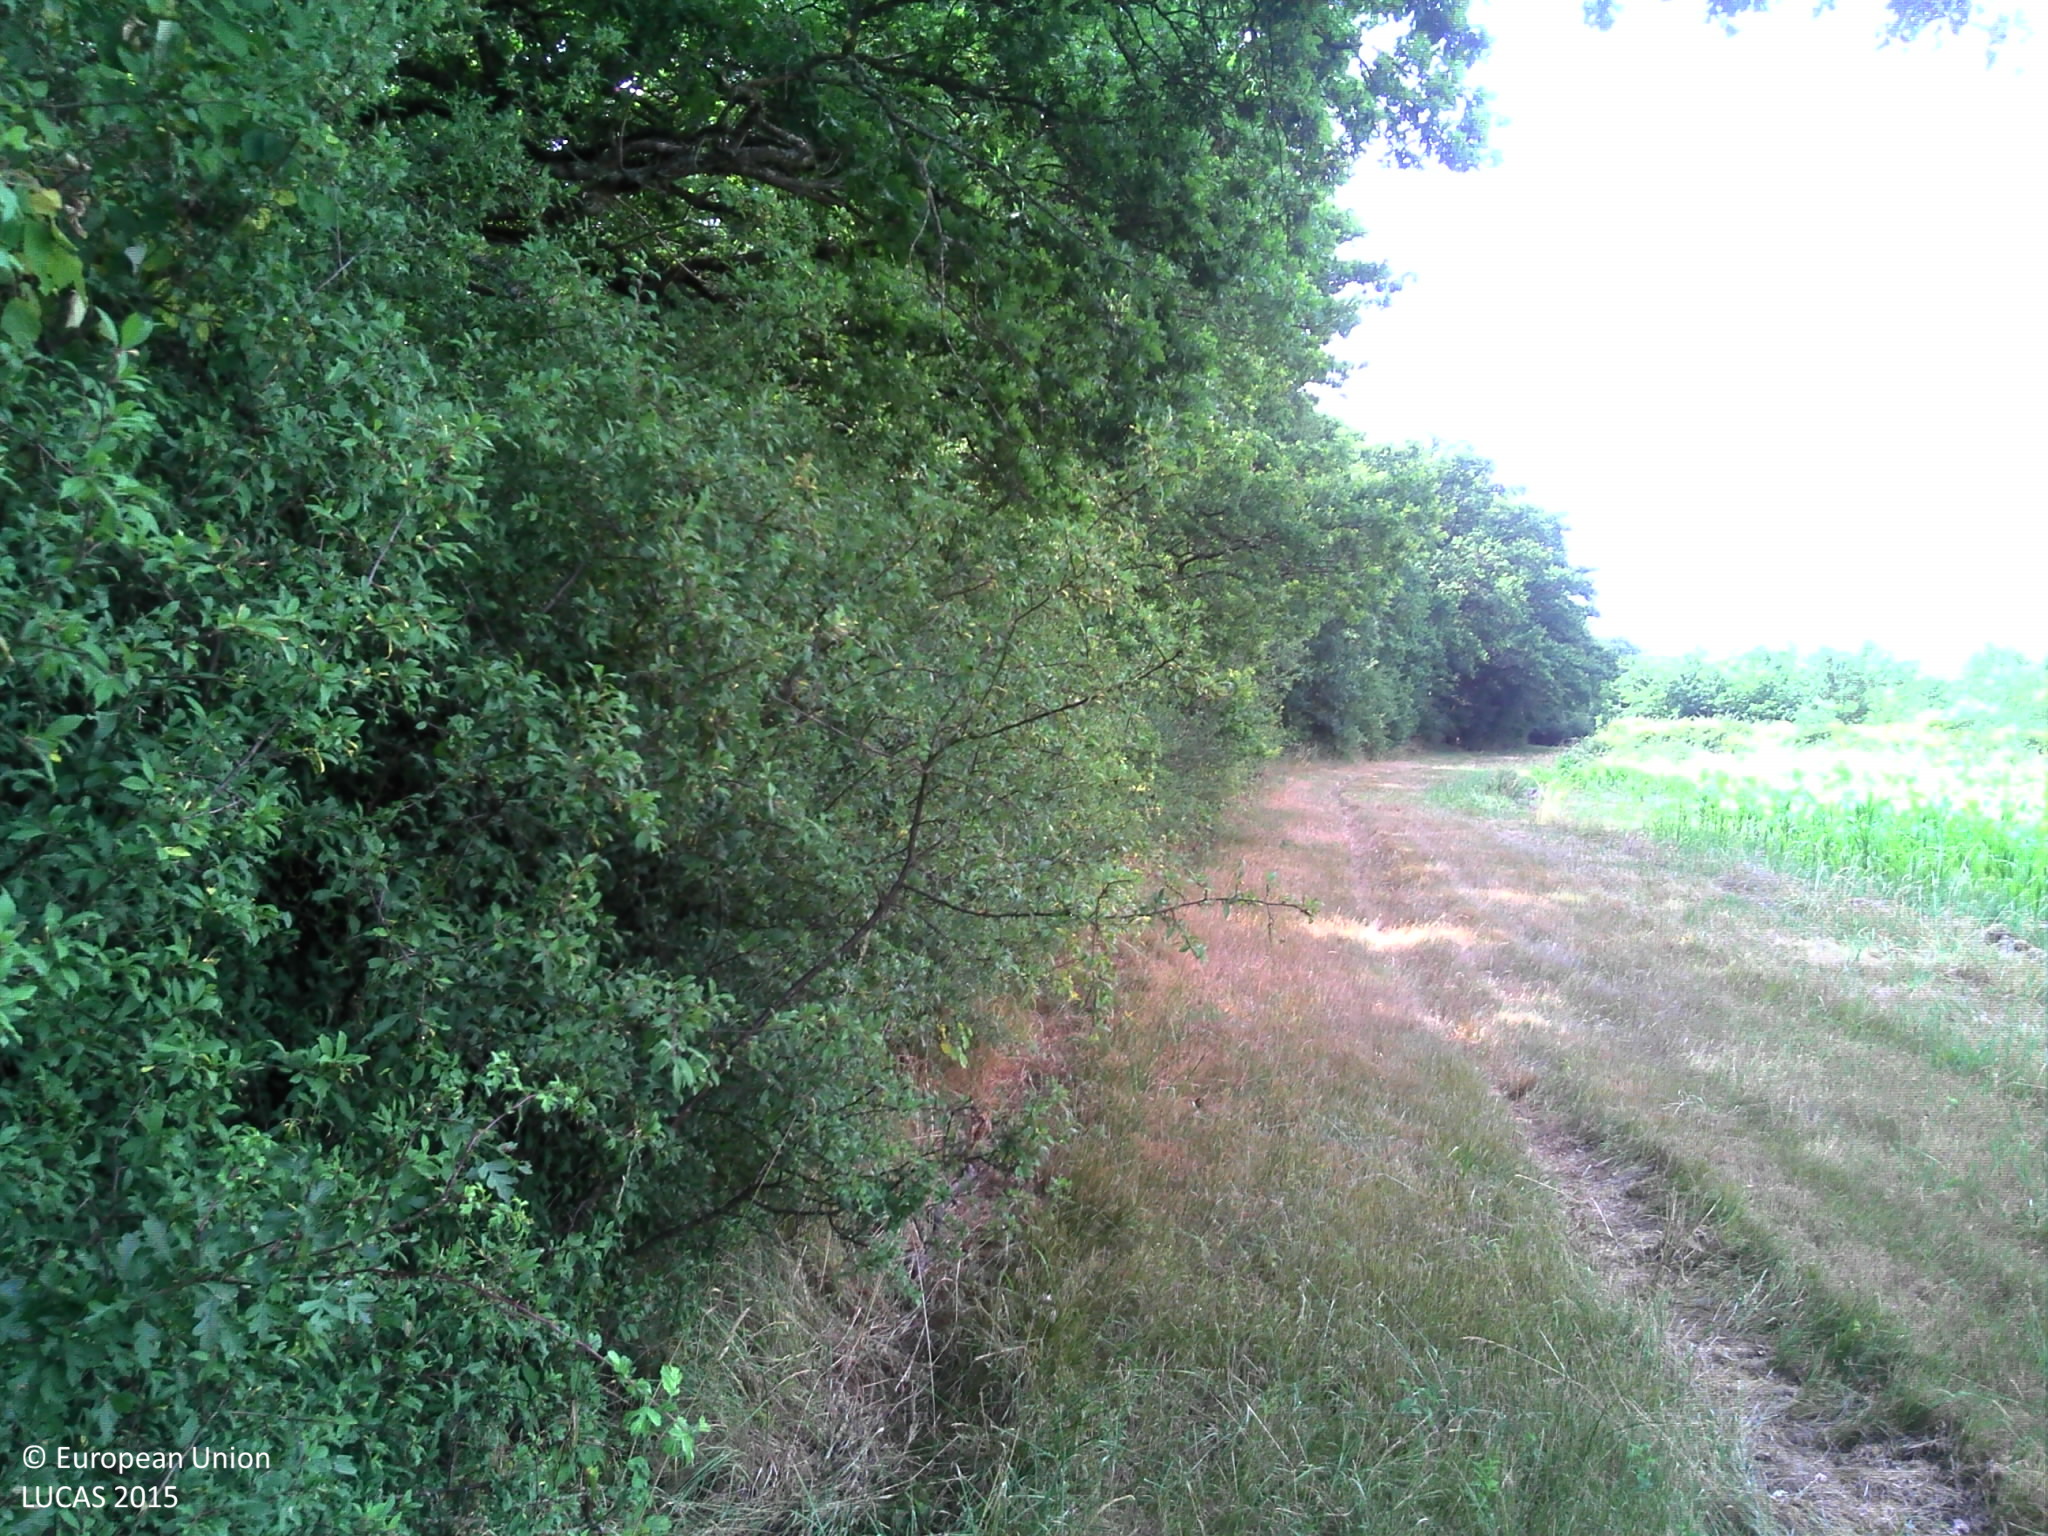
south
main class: Woodland
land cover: Broadleaved woodland
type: mesophytic deciduous forest
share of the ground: > 75 %
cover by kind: broadleaved forest trees 100 %
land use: Agriculture (excluding fallow land and kitchen gardens)
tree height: > 5 m
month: July
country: FR
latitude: 47.7354
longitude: 2.8053
